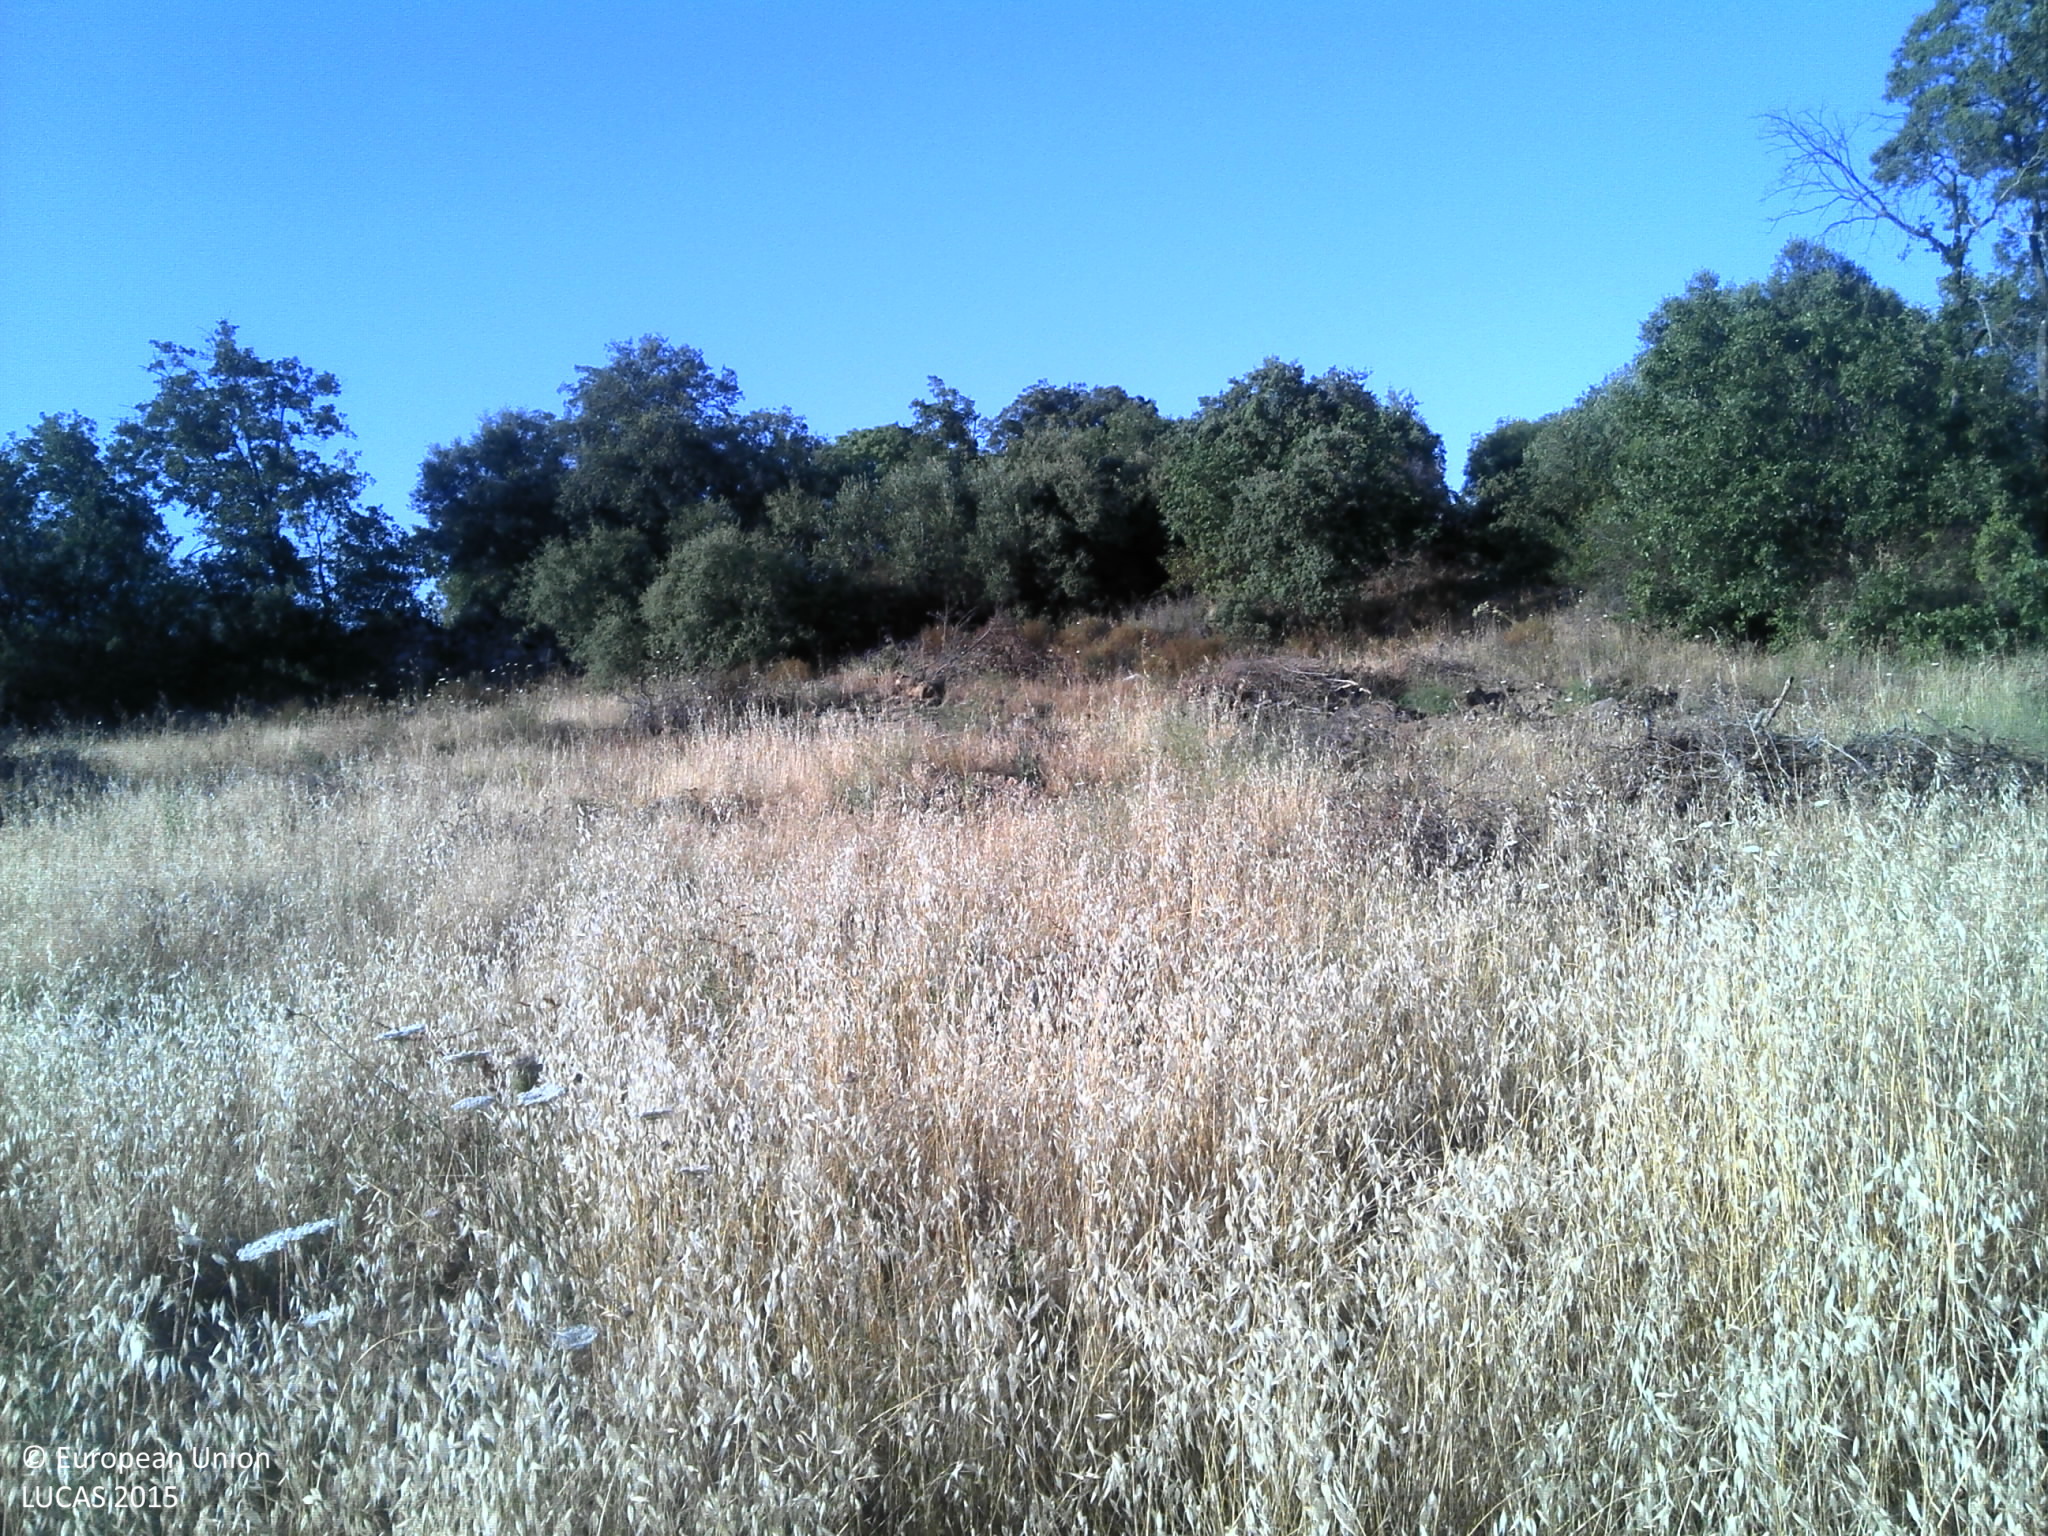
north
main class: Grassland
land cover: Grassland with sparse tree/shrub cover
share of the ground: 50 - 75 %
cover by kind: herbaceous plants 70 %, unconsolidated bare surface 20 %, broadleaved forest trees 5 %
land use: Agriculture (excluding fallow land and kitchen gardens)
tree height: > 5 m
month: June
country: PT
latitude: 39.9684
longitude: -7.3197
